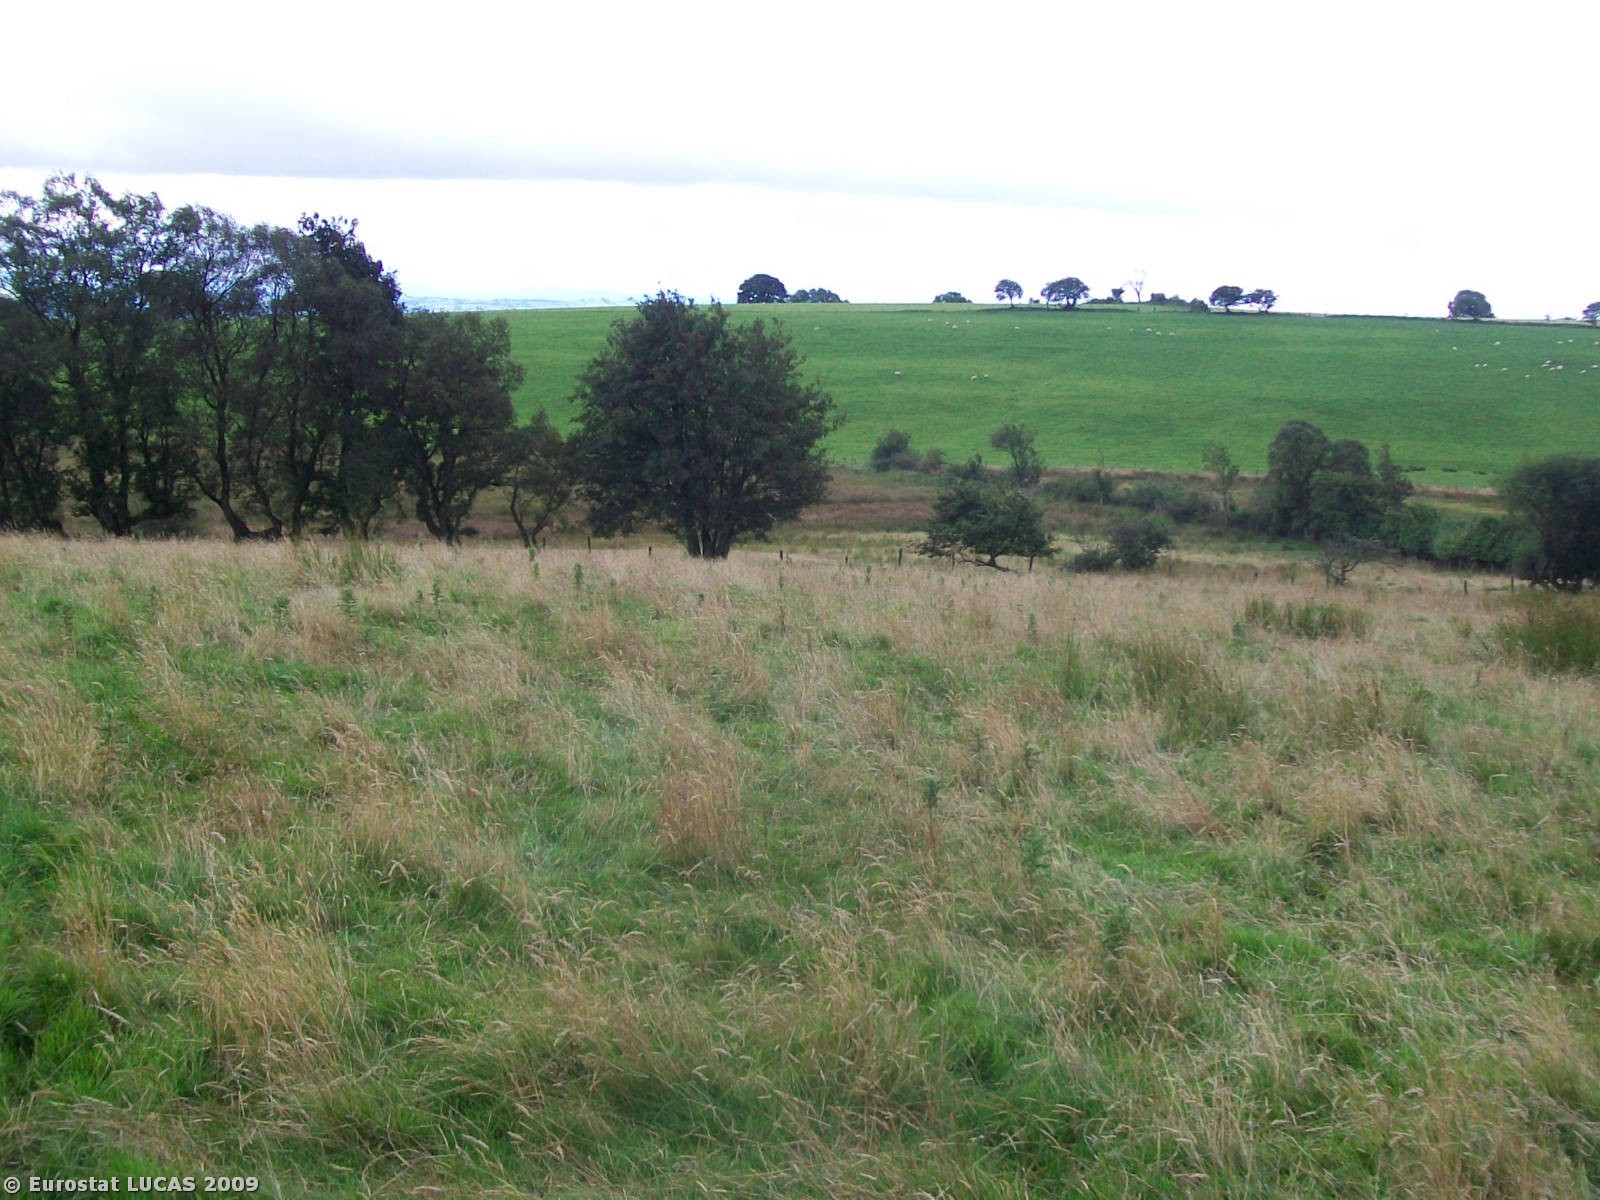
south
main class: Grassland
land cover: Grassland without tree/shrub cover
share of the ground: > 75 %
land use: Agriculture (excluding fallow land and kitchen gardens)
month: August
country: GB
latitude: 52.7616
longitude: -3.4047
